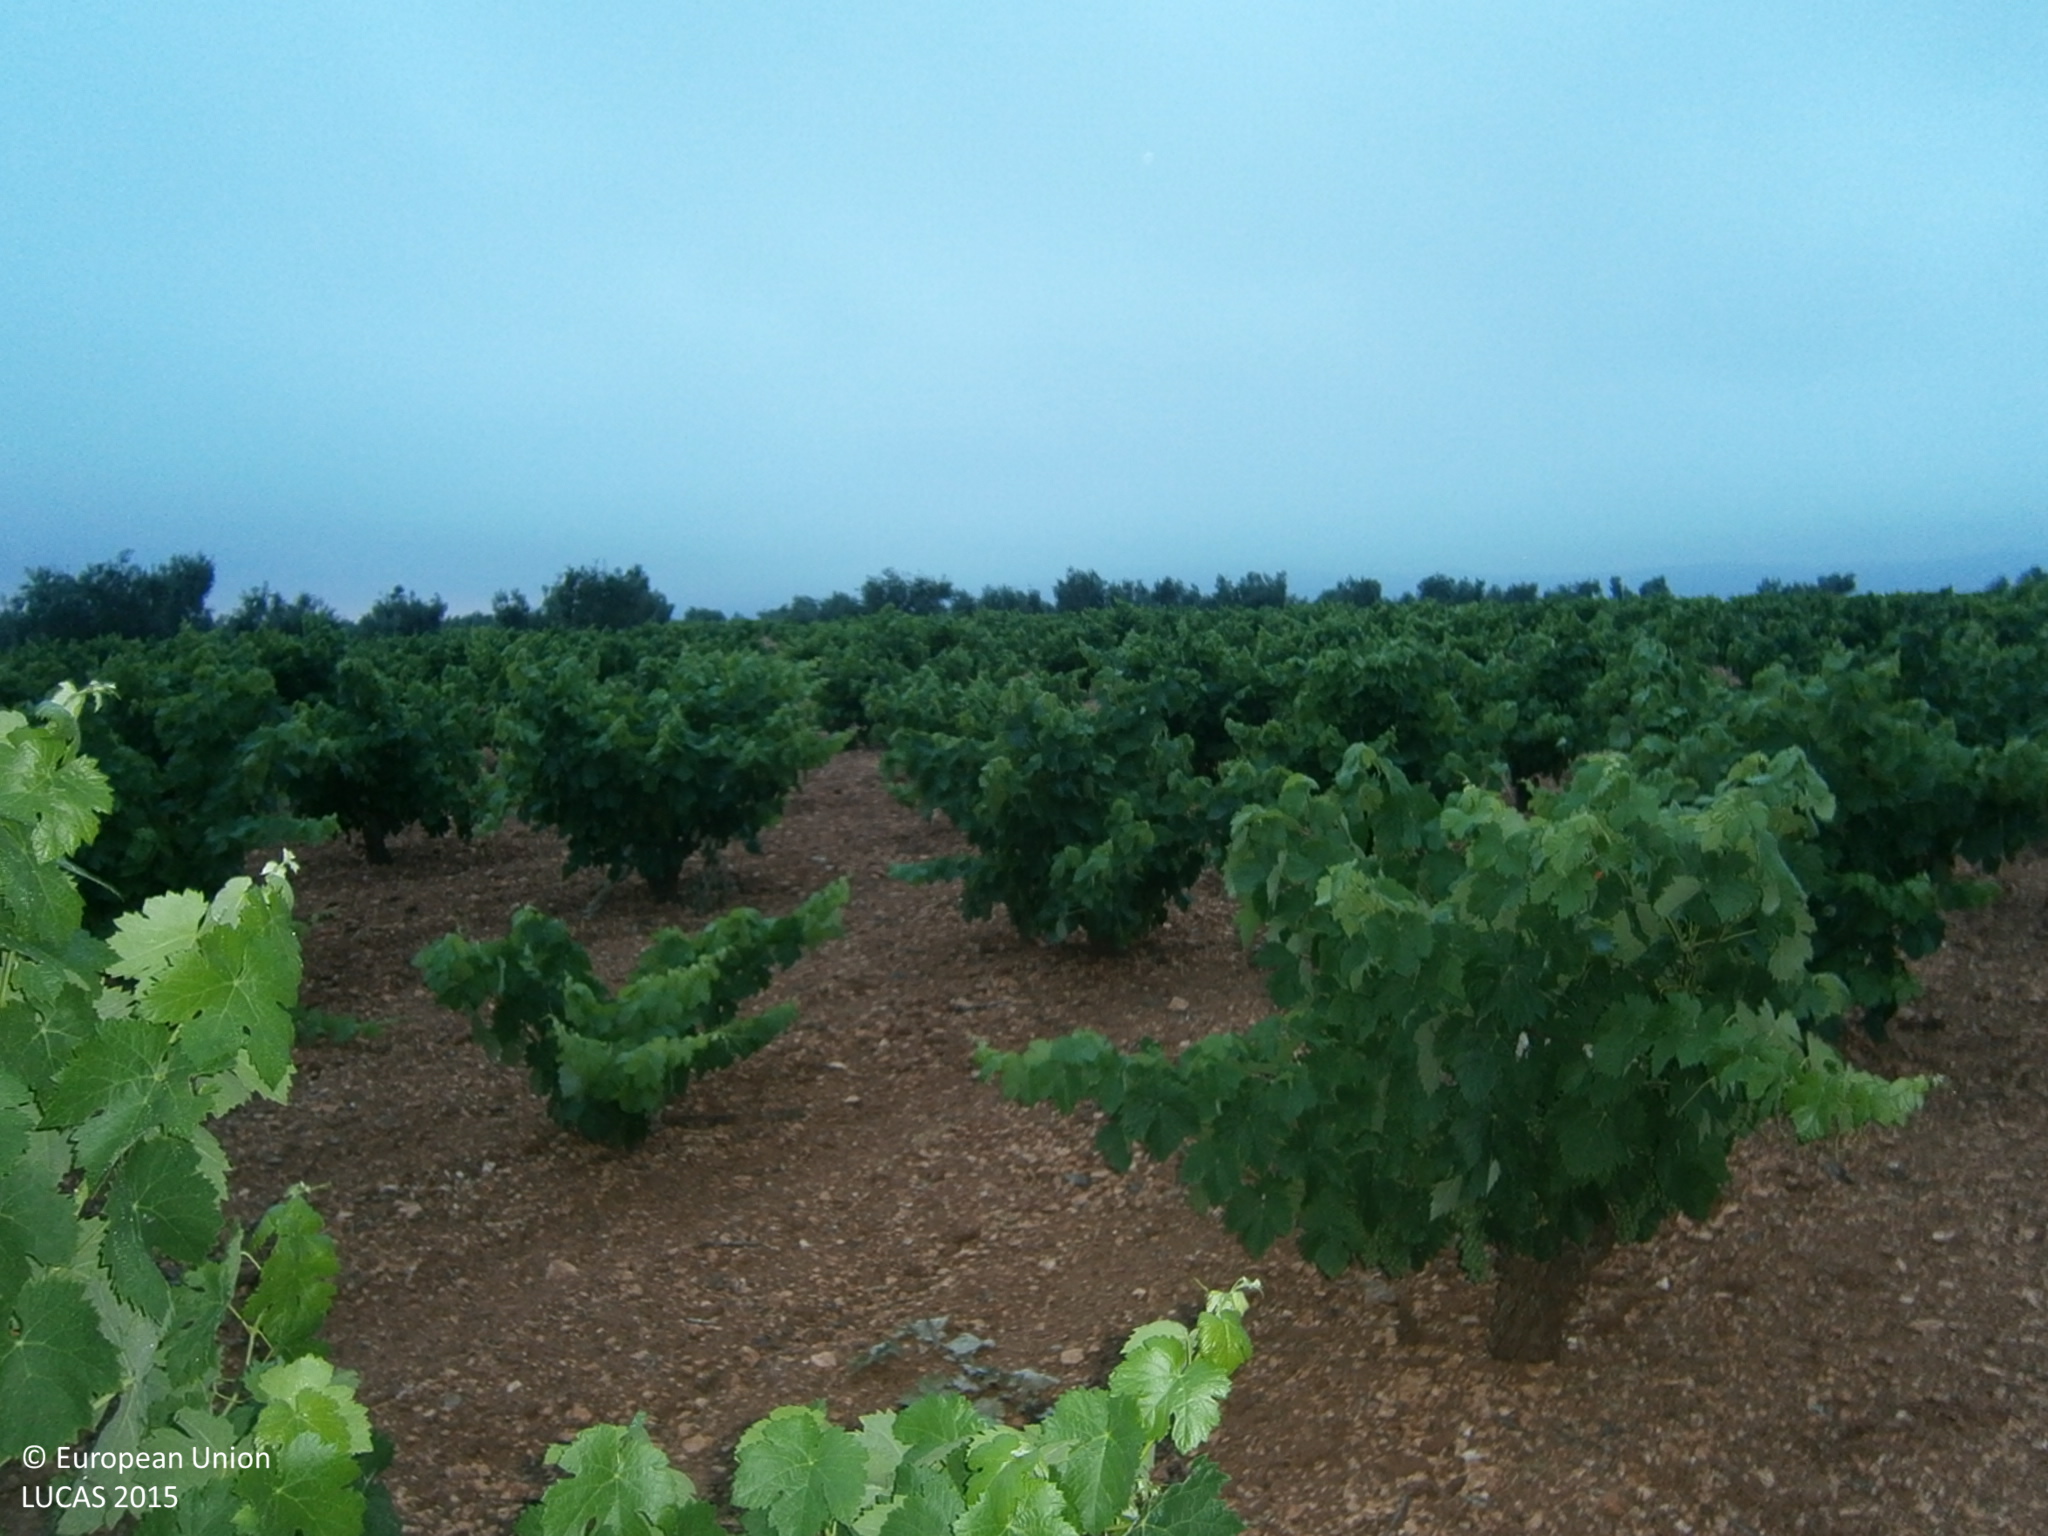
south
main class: Cropland
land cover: Vineyards
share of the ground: 25 - 50 %
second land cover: Other bare soil
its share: > 75 %
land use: Agriculture (excluding fallow land and kitchen gardens)
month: June
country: ES
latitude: 38.5623
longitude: -6.4063
